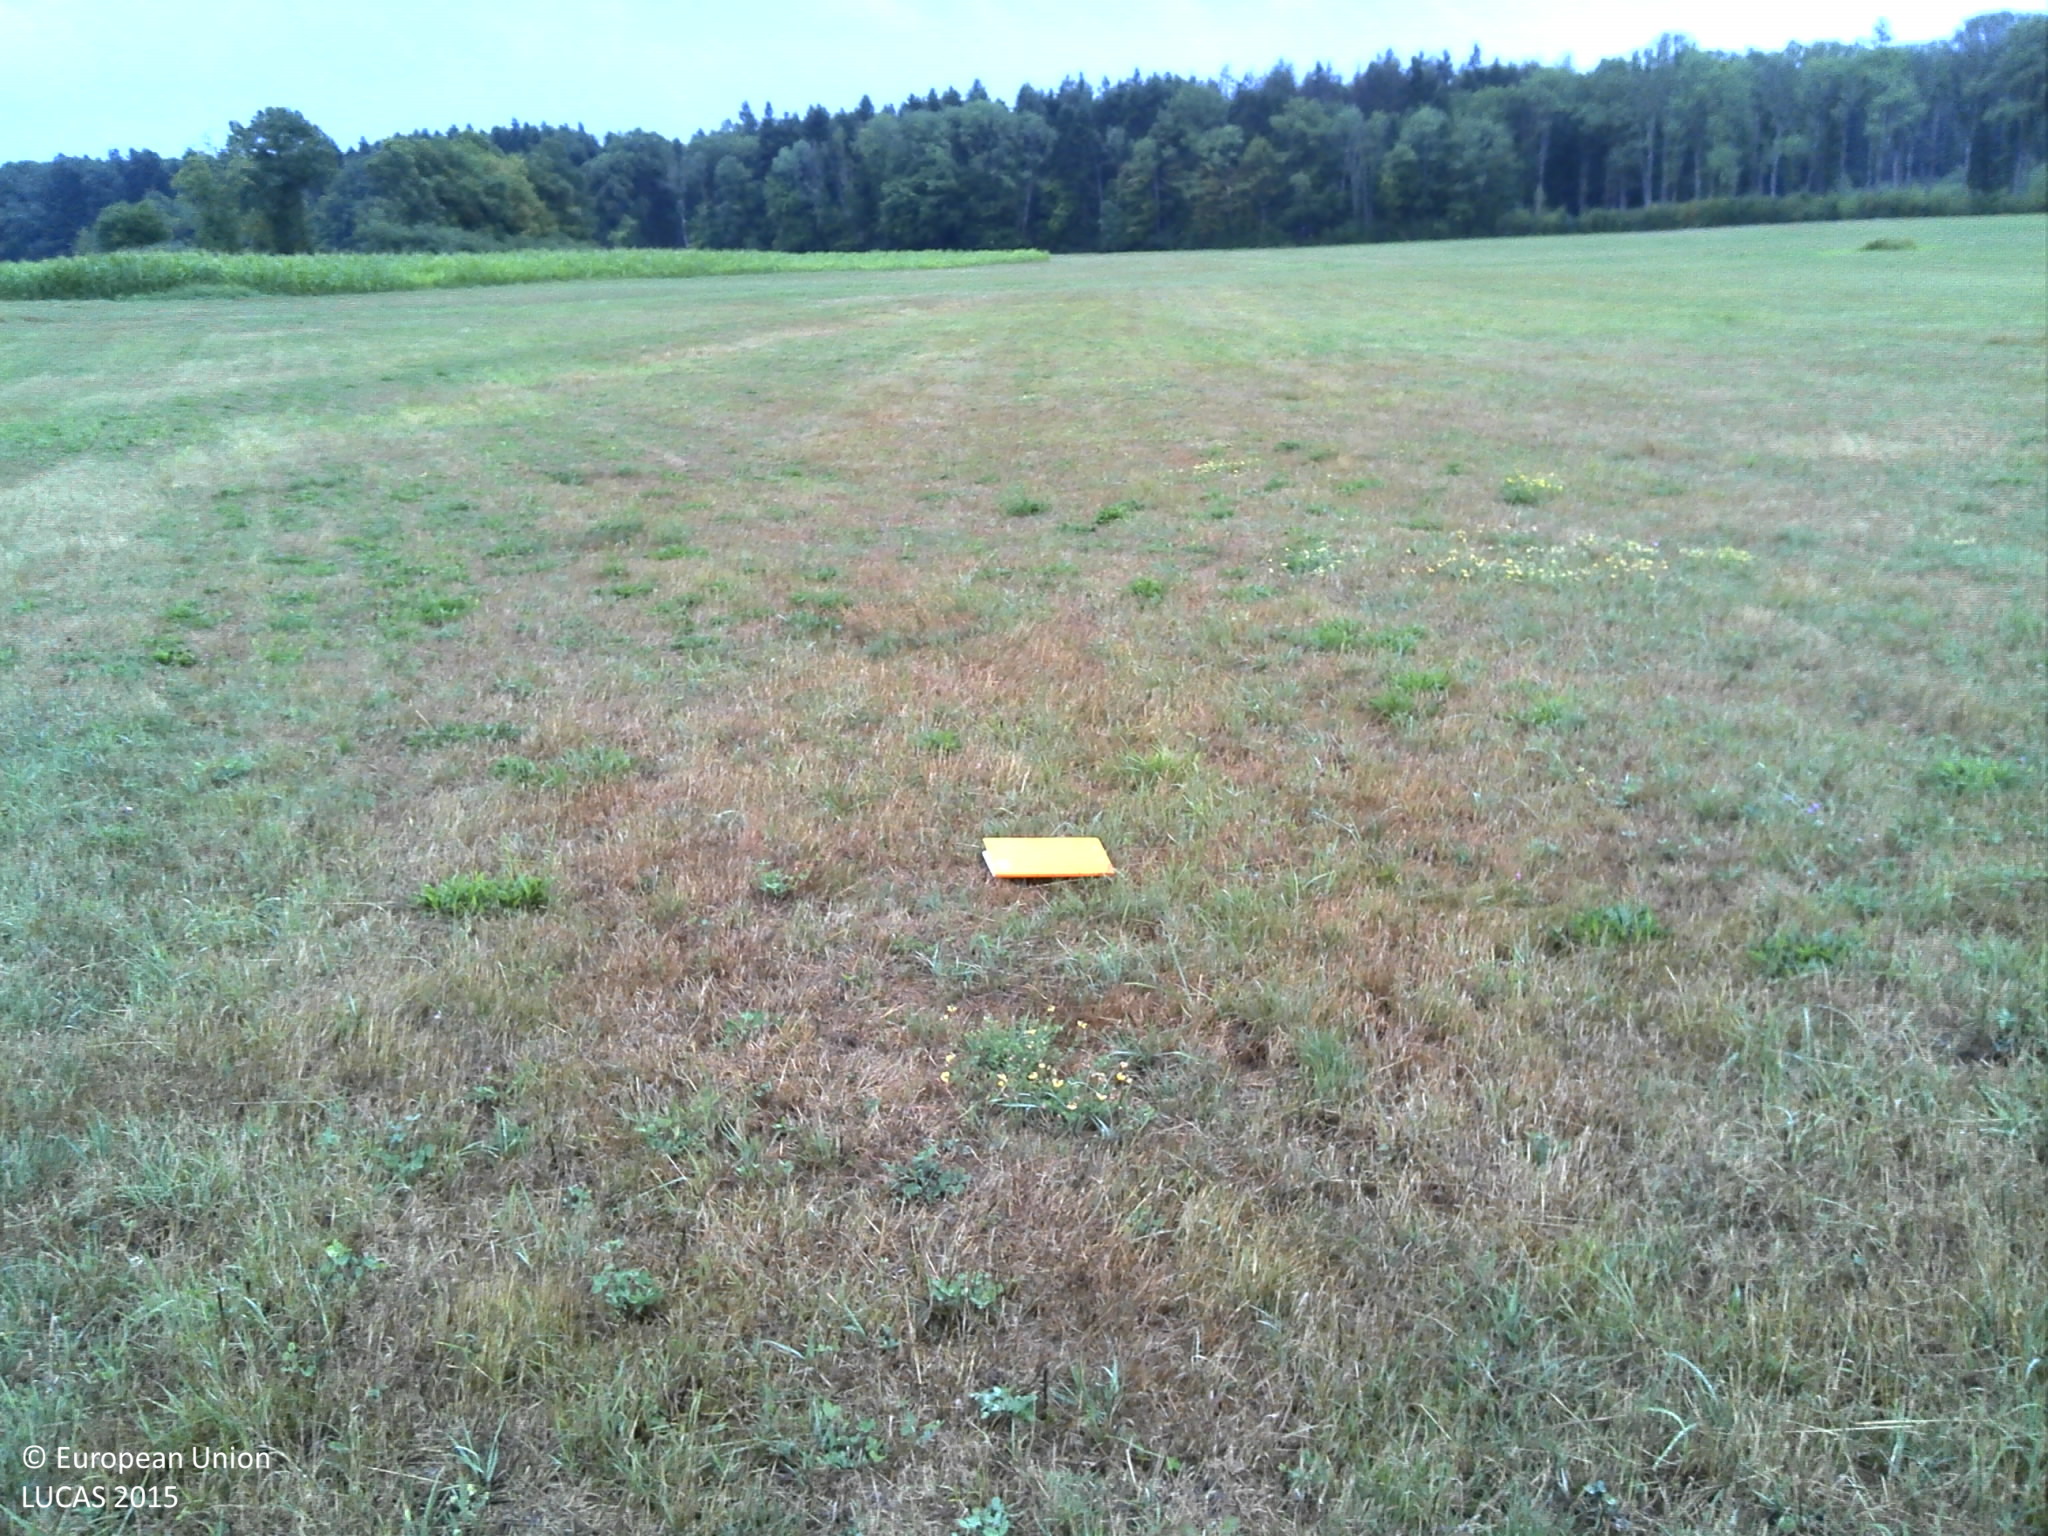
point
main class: Grassland
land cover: Grassland without tree/shrub cover
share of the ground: > 75 %
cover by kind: herbaceous plants 100 %
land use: Agriculture (excluding fallow land and kitchen gardens)
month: July
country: FR
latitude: 47.9423
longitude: 6.2121
